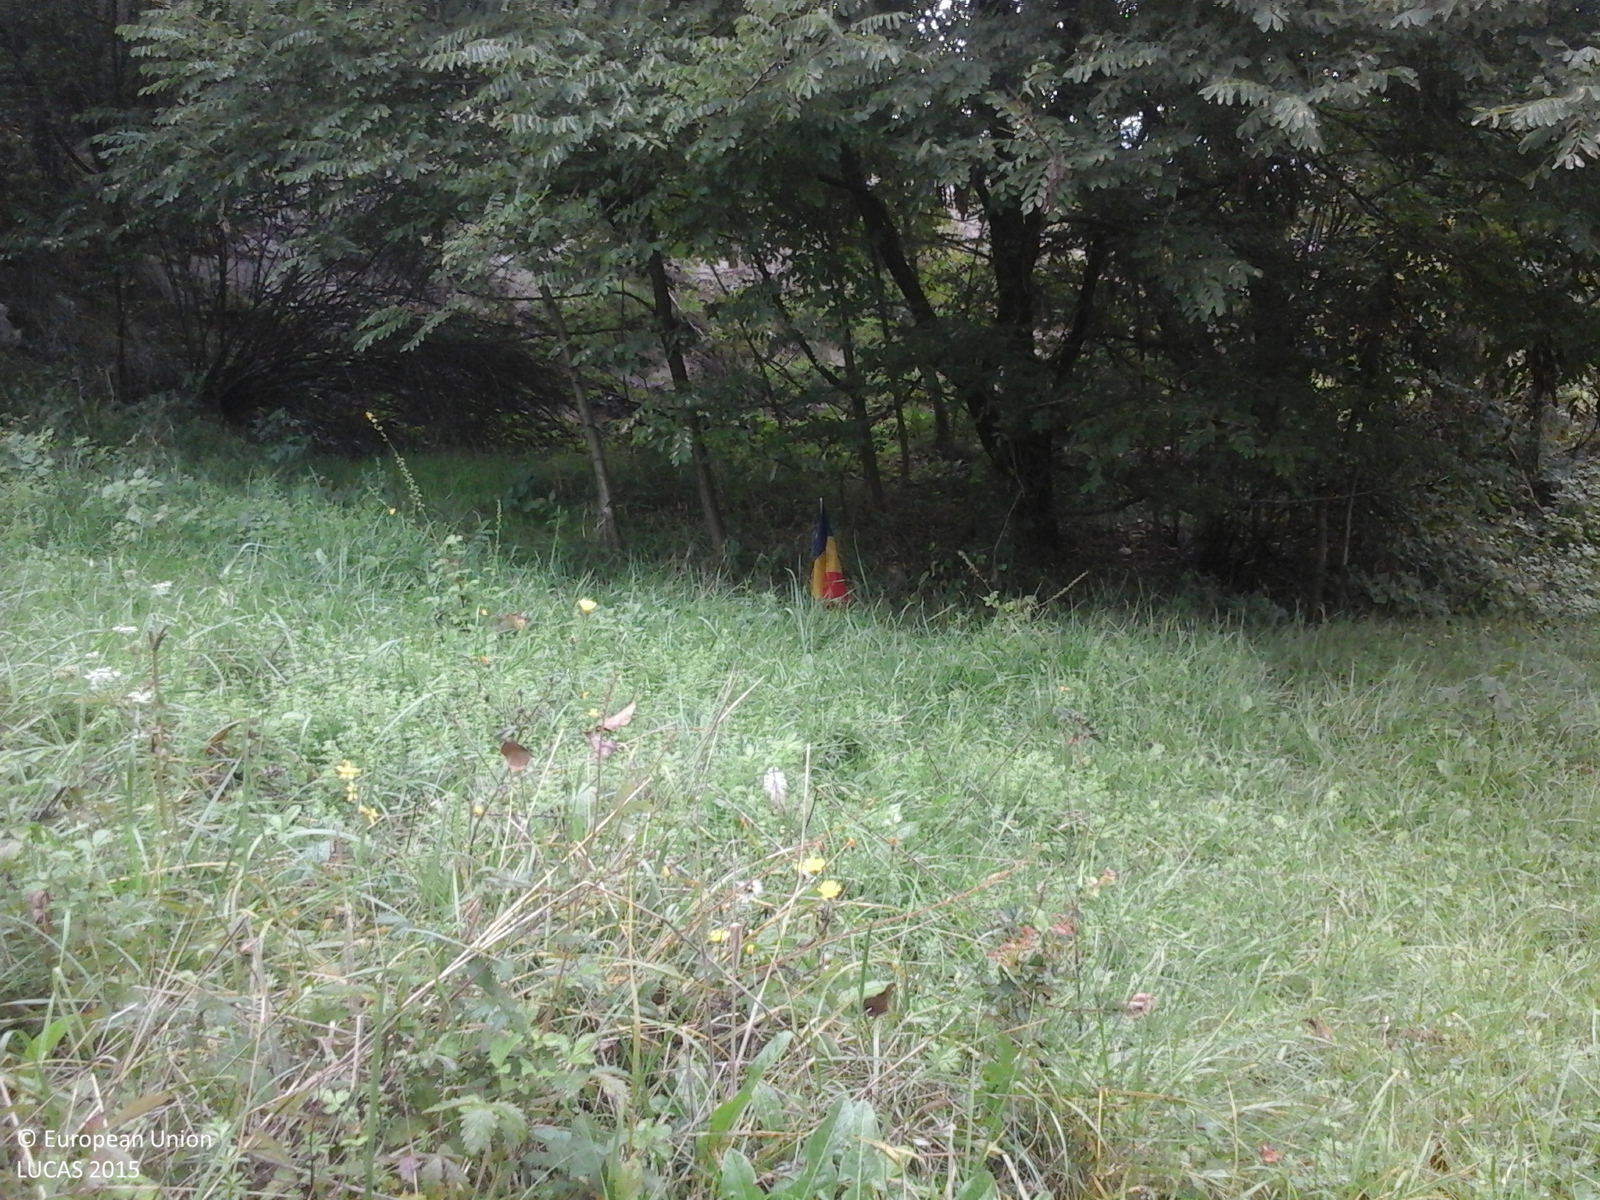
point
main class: Woodland
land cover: Broadleaved woodland
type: exotic forest
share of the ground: > 75 %
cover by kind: broadleaved forest trees 100 %
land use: Forestry
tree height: > 5 m
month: September
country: RO
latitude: 44.8844
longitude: 23.1029
